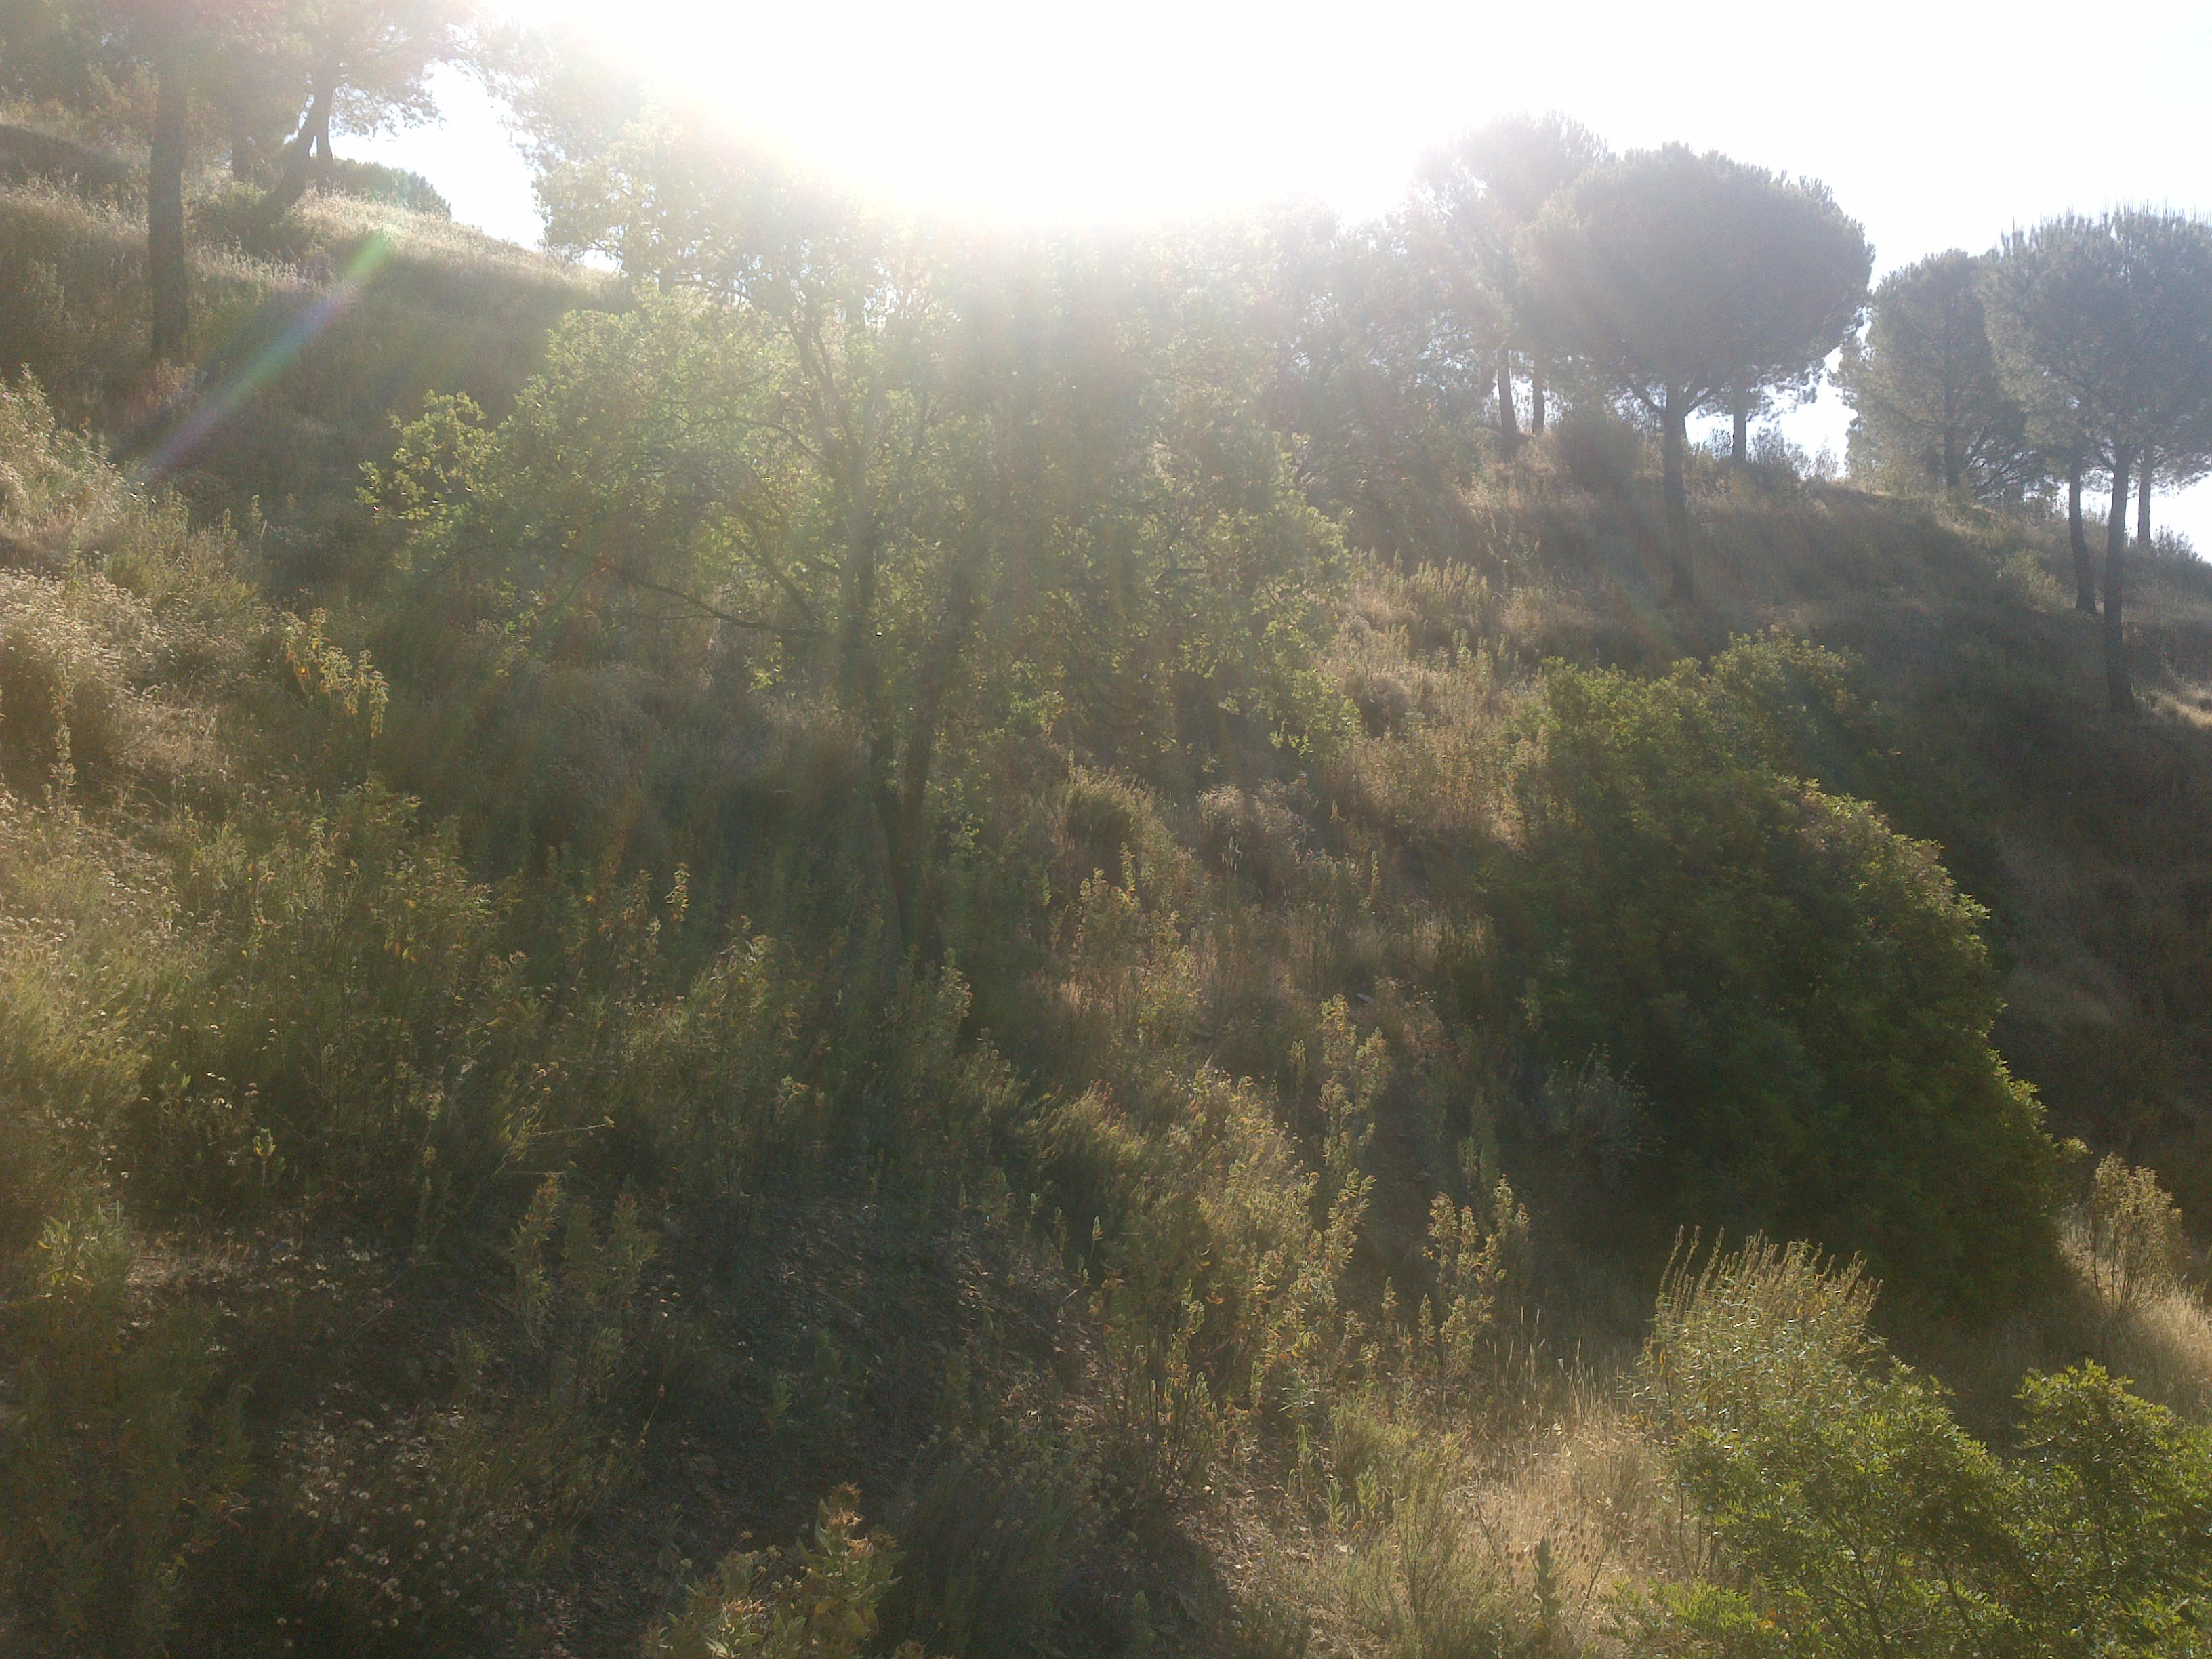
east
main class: Woodland
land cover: Pine dominated coniferous woodland
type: coniferous forest of the mediterranean region
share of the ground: 10 - 25 %
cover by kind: herbaceous plants 60 %, coniferous forest trees 20 %, shrubs 15 %, broadleaved forest trees 5 %
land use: Forestry
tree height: > 5 m
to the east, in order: Pine dominated coniferous woodland; Grass margins; Paved roads, cycling and walking lanes; Grass margins; Pine dominated coniferous woodland
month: May
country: ES
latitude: 38.0361
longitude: -4.6790
